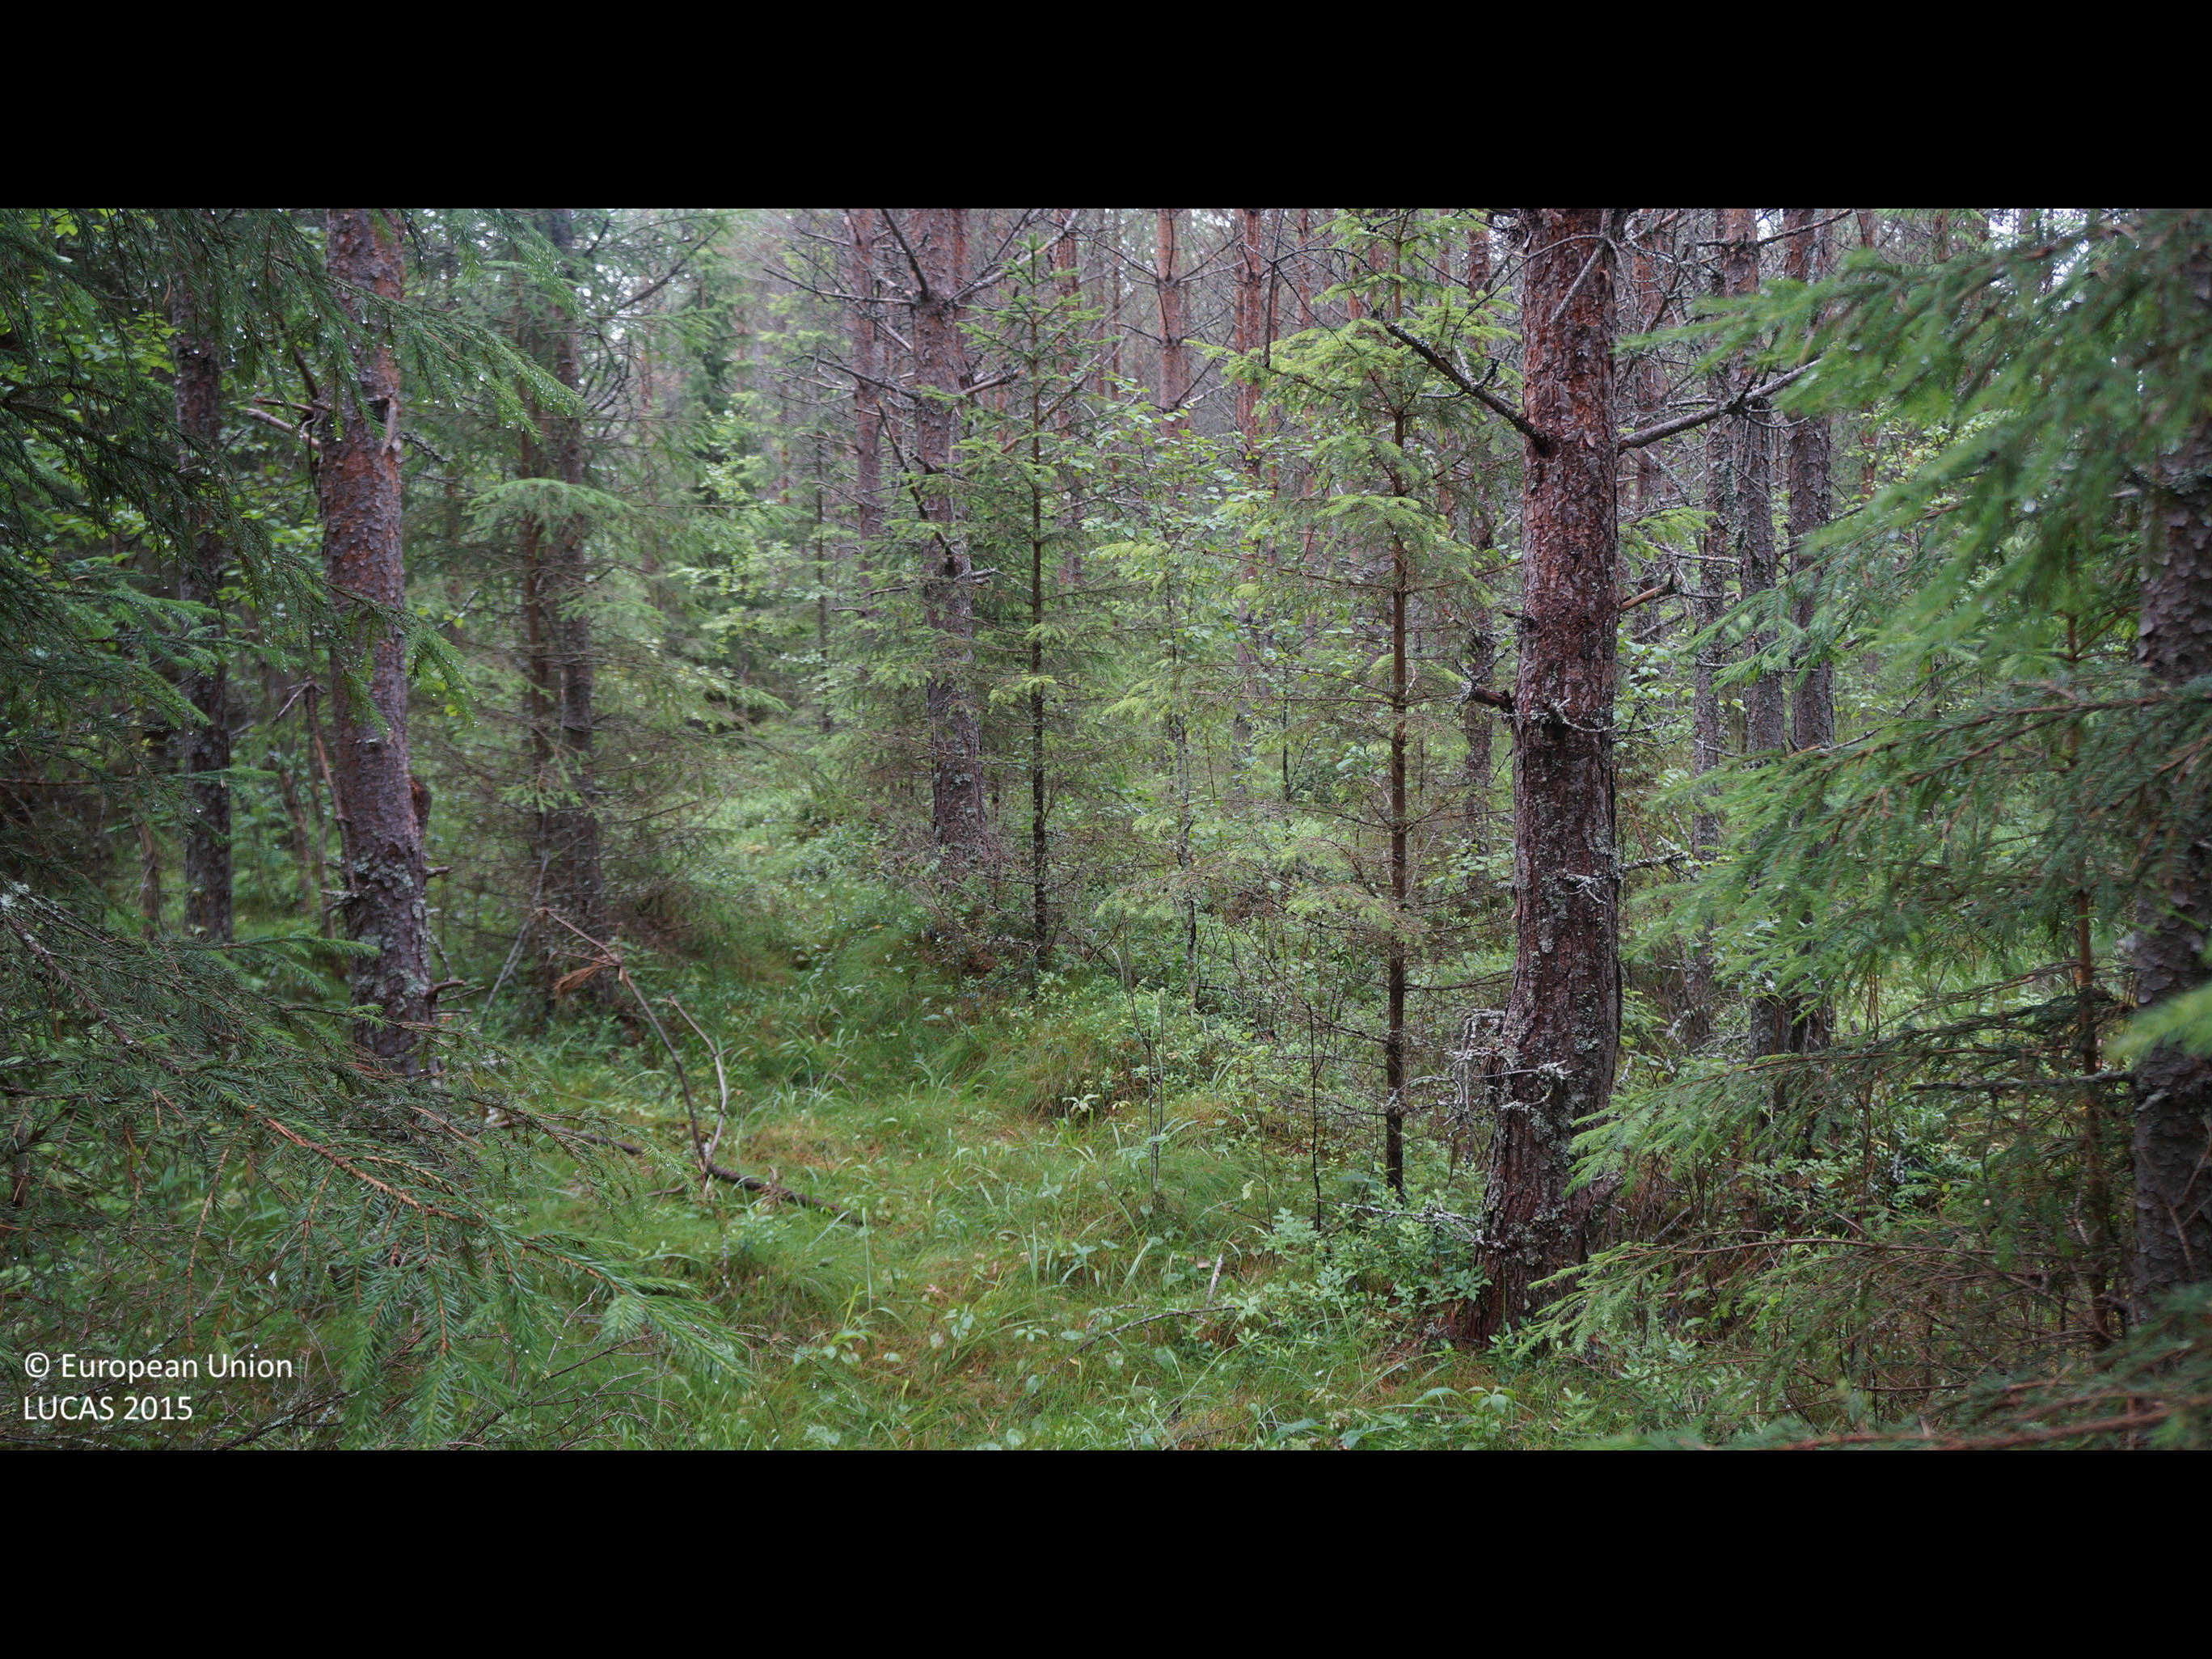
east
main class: Woodland
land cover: Pine dominated mixed woodland
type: boreal forest
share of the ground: > 75 %
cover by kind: coniferous forest trees 55 %, broadleaved forest trees 20 %, herbaceous plants 15 %, shrubs 10 %
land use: Forestry
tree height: > 5 m
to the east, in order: Pine dominated mixed woodland; Pine dominated coniferous woodland; Ditches and canals; Pine dominated coniferous woodland; Ditches and canals; Pine dominated coniferous woodland; Spruce dominated mixed woodland; Grassland without tree/shrub cover; Tracks; Shruby margins; Ditches and canals; Spruce dominated mixed woodland; Ditches and canals; Spruce dominated mixed woodland; Ditches and canals; Broadleaved woodland; Ditches and canals; Spruce dominated mixed woodland; Spruce dominated coniferous woodland; Ditches and canals; Spruce dominated coniferous woodland
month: July
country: FI
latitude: 64.4152
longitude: 24.8329
